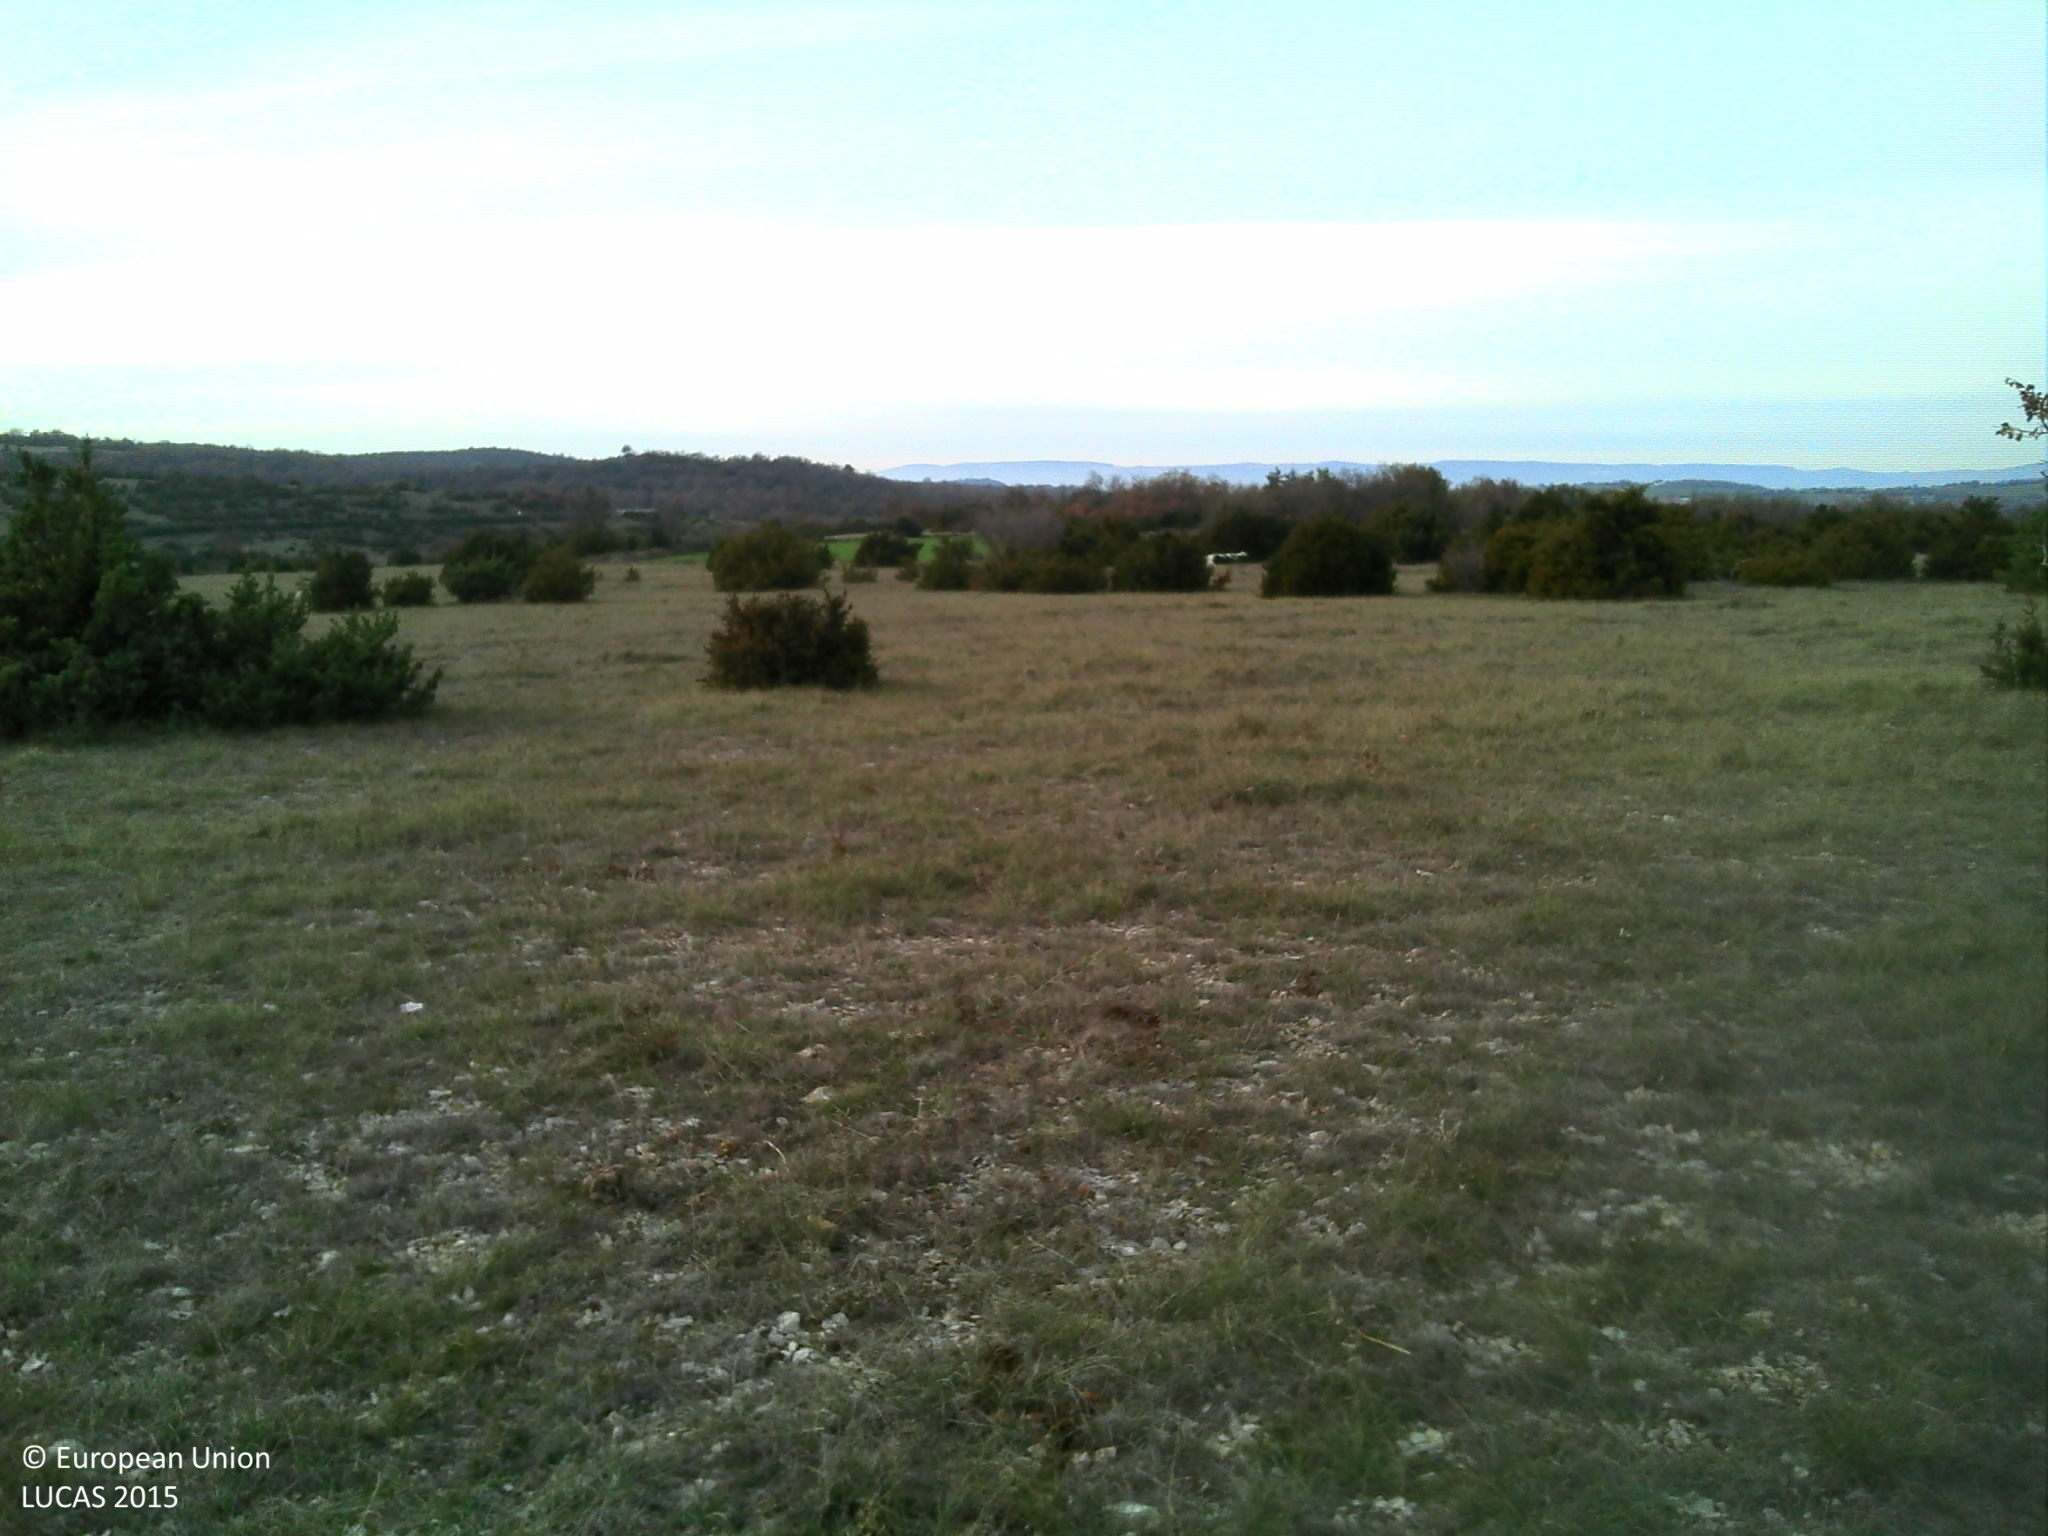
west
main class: Shrubland
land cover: Shrubland with sparse tree cover
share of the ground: > 75 %
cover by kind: herbaceous plants 70 %, shrubs 15 %, broadleaved forest trees 5 %, consolidated bare surface 5 %, unconsolidated bare surface 5 %
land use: Agriculture (excluding fallow land and kitchen gardens)
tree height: < 5 m
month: November
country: FR
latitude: 44.0699
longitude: 3.1516
